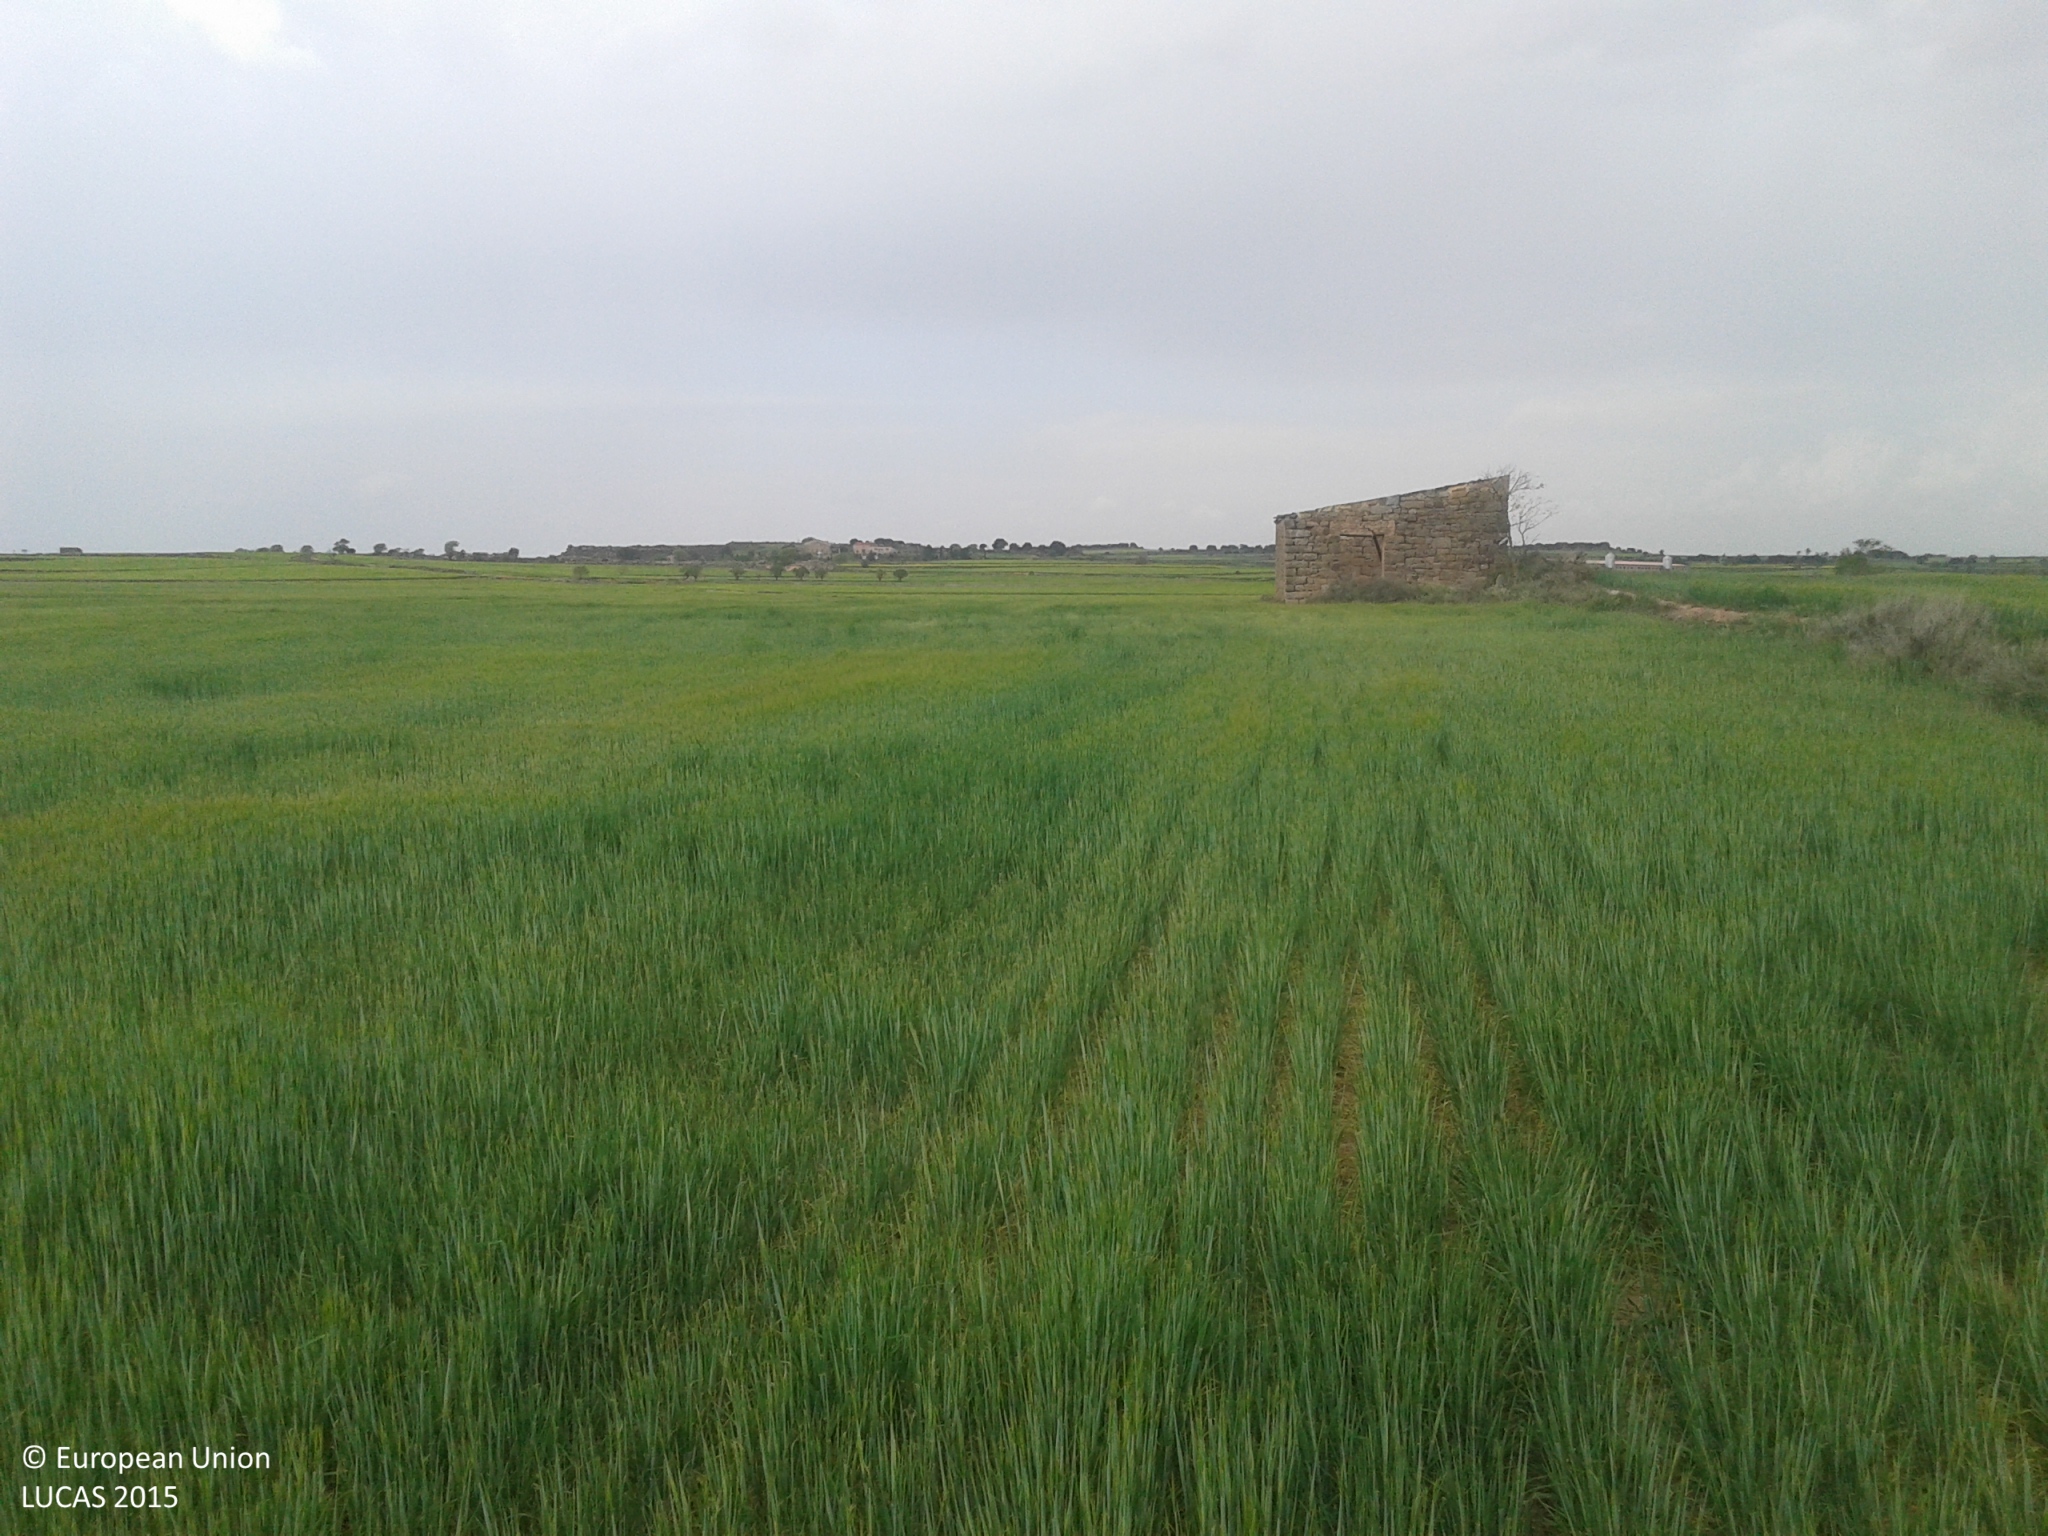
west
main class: Cropland
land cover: Barley
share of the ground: > 75 %
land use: Agriculture (excluding fallow land and kitchen gardens)
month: April
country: ES
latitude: 41.7394
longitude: 1.1514
